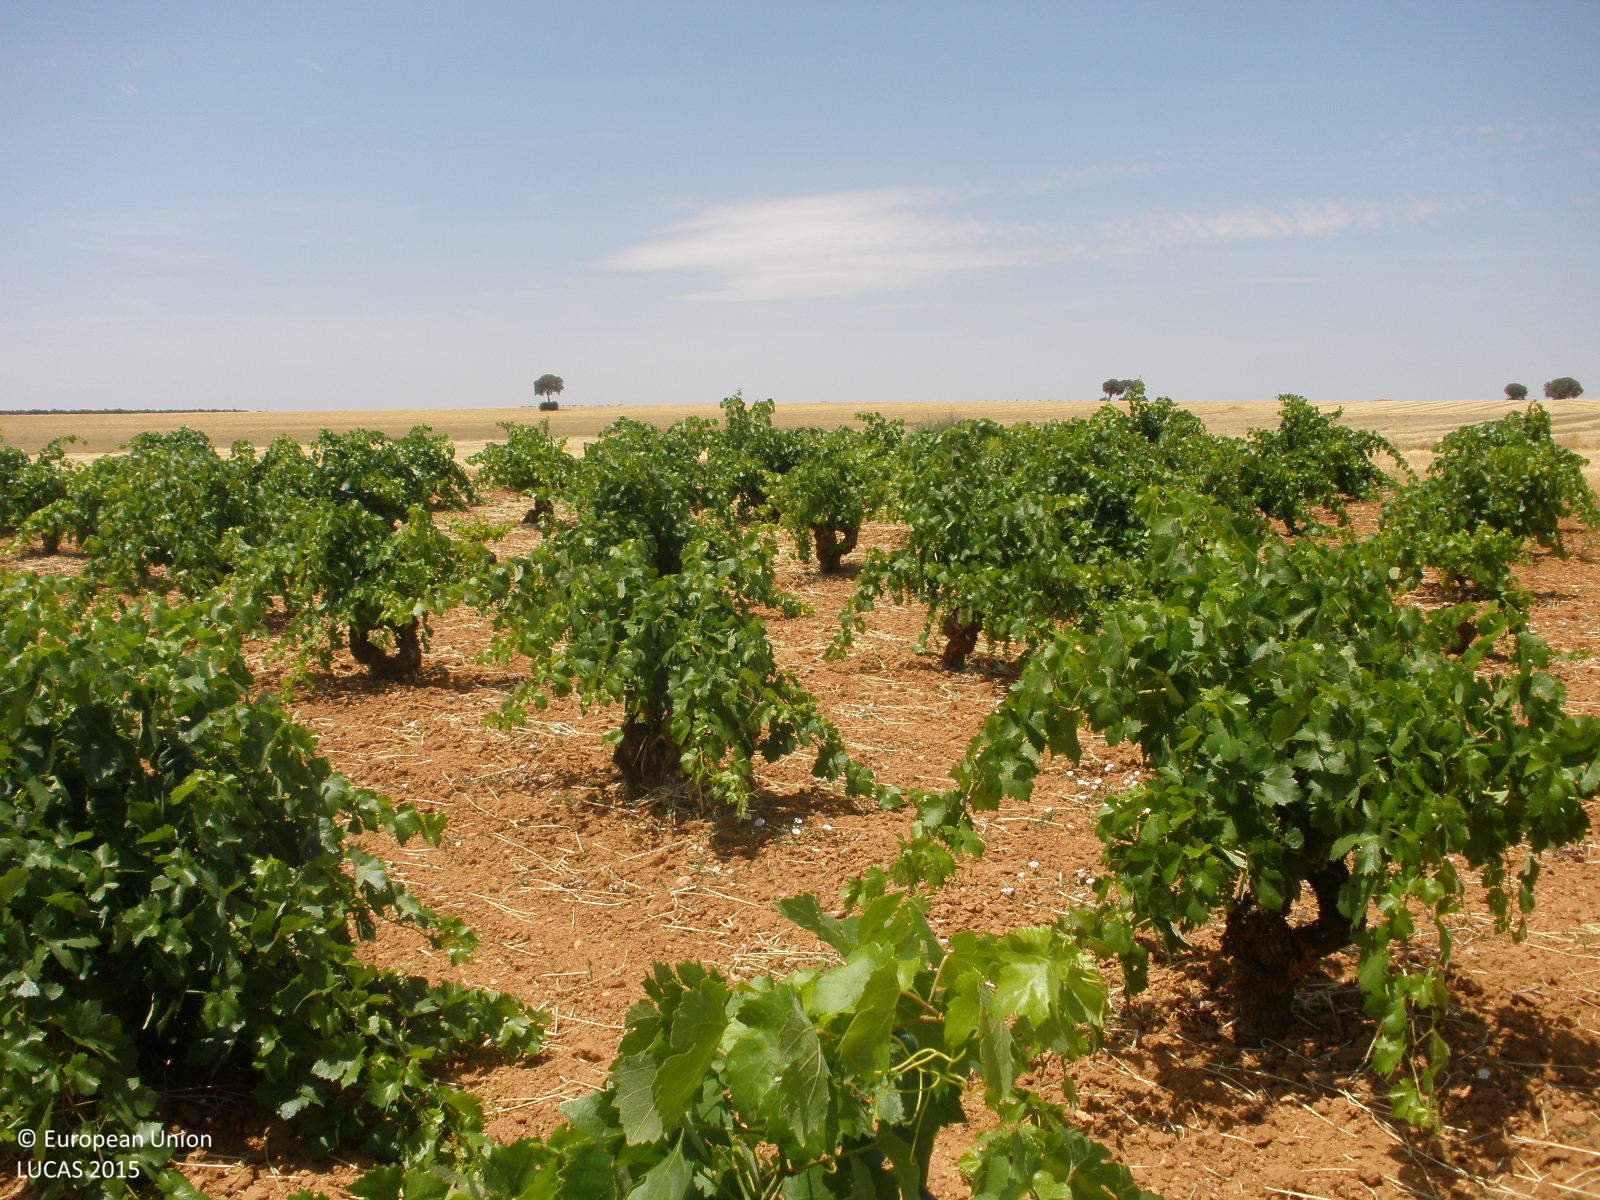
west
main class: Cropland
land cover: Vineyards
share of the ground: 50 - 75 %
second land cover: Other bare soil
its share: > 75 %
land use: Agriculture (excluding fallow land and kitchen gardens)
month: July
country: ES
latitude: 39.8980
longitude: -3.2295
